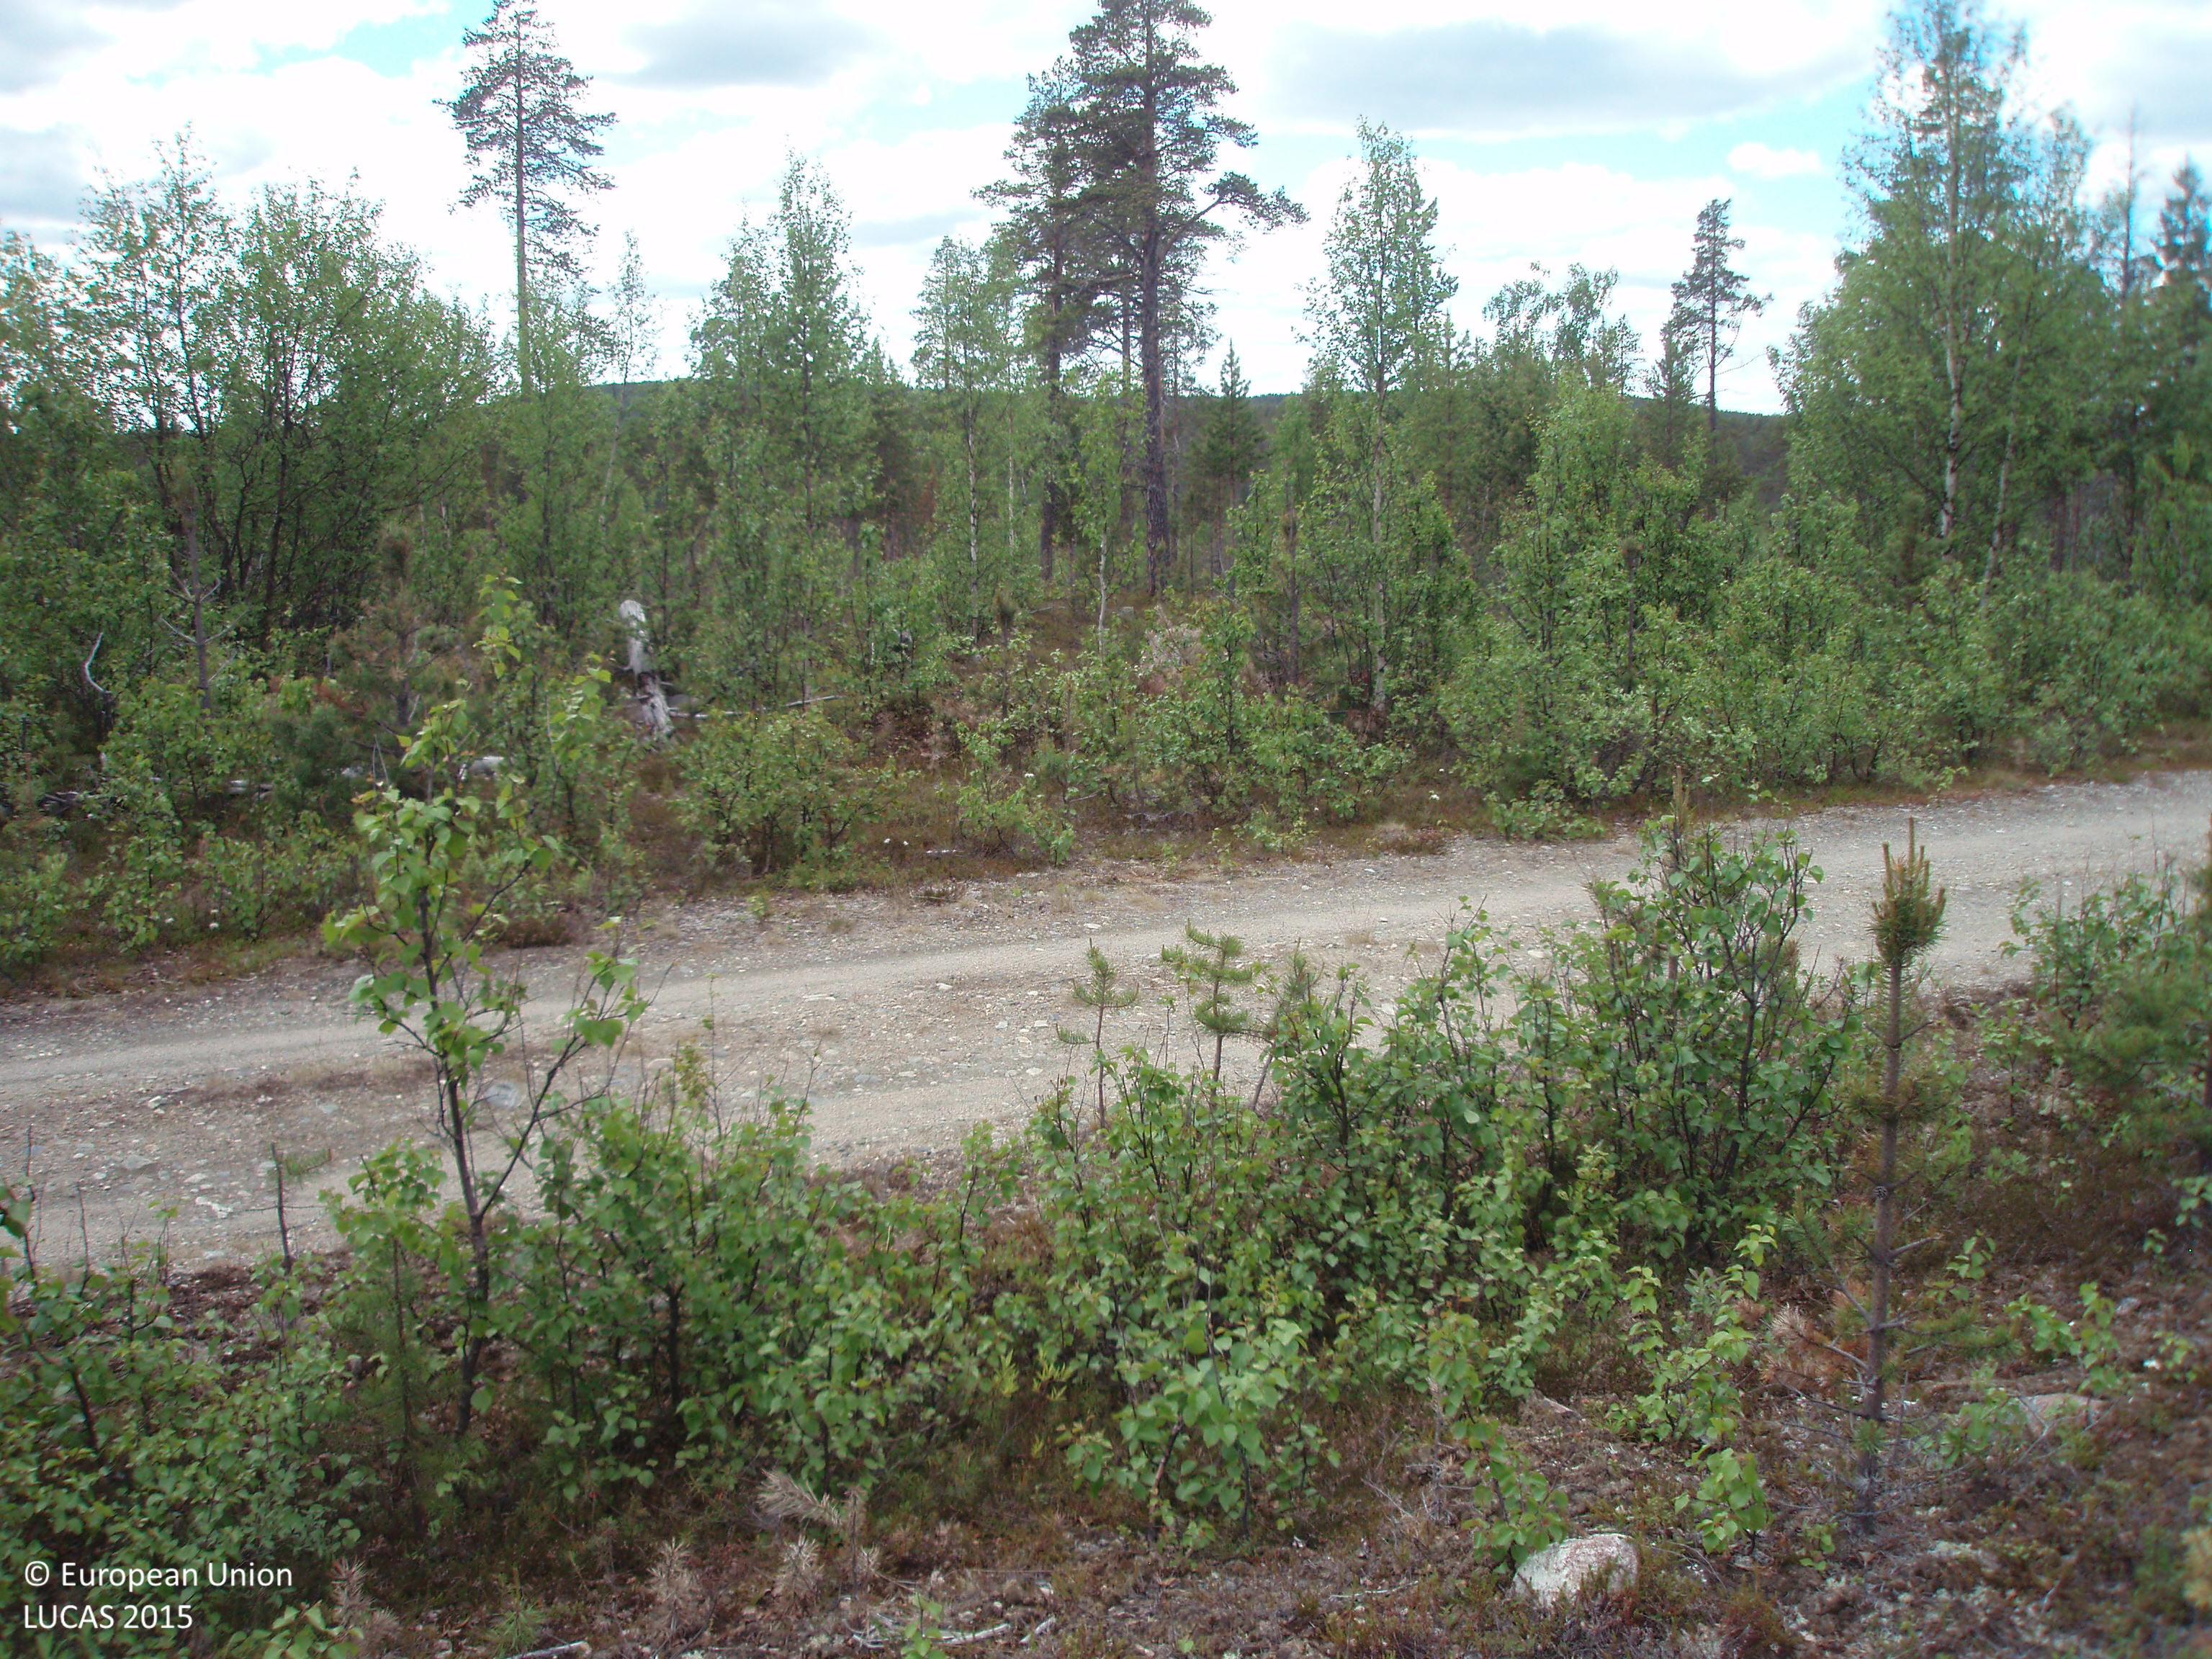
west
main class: Woodland
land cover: Pine dominated mixed woodland
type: boreal forest
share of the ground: 50 - 75 %
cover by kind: coniferous forest trees 30 %, shrubs 30 %, broadleaved forest trees 20 %, unconsolidated bare surface 20 %
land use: Forestry
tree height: > 5 m
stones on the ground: < 10 %
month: July
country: FI
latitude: 68.8732
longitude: 25.7690
